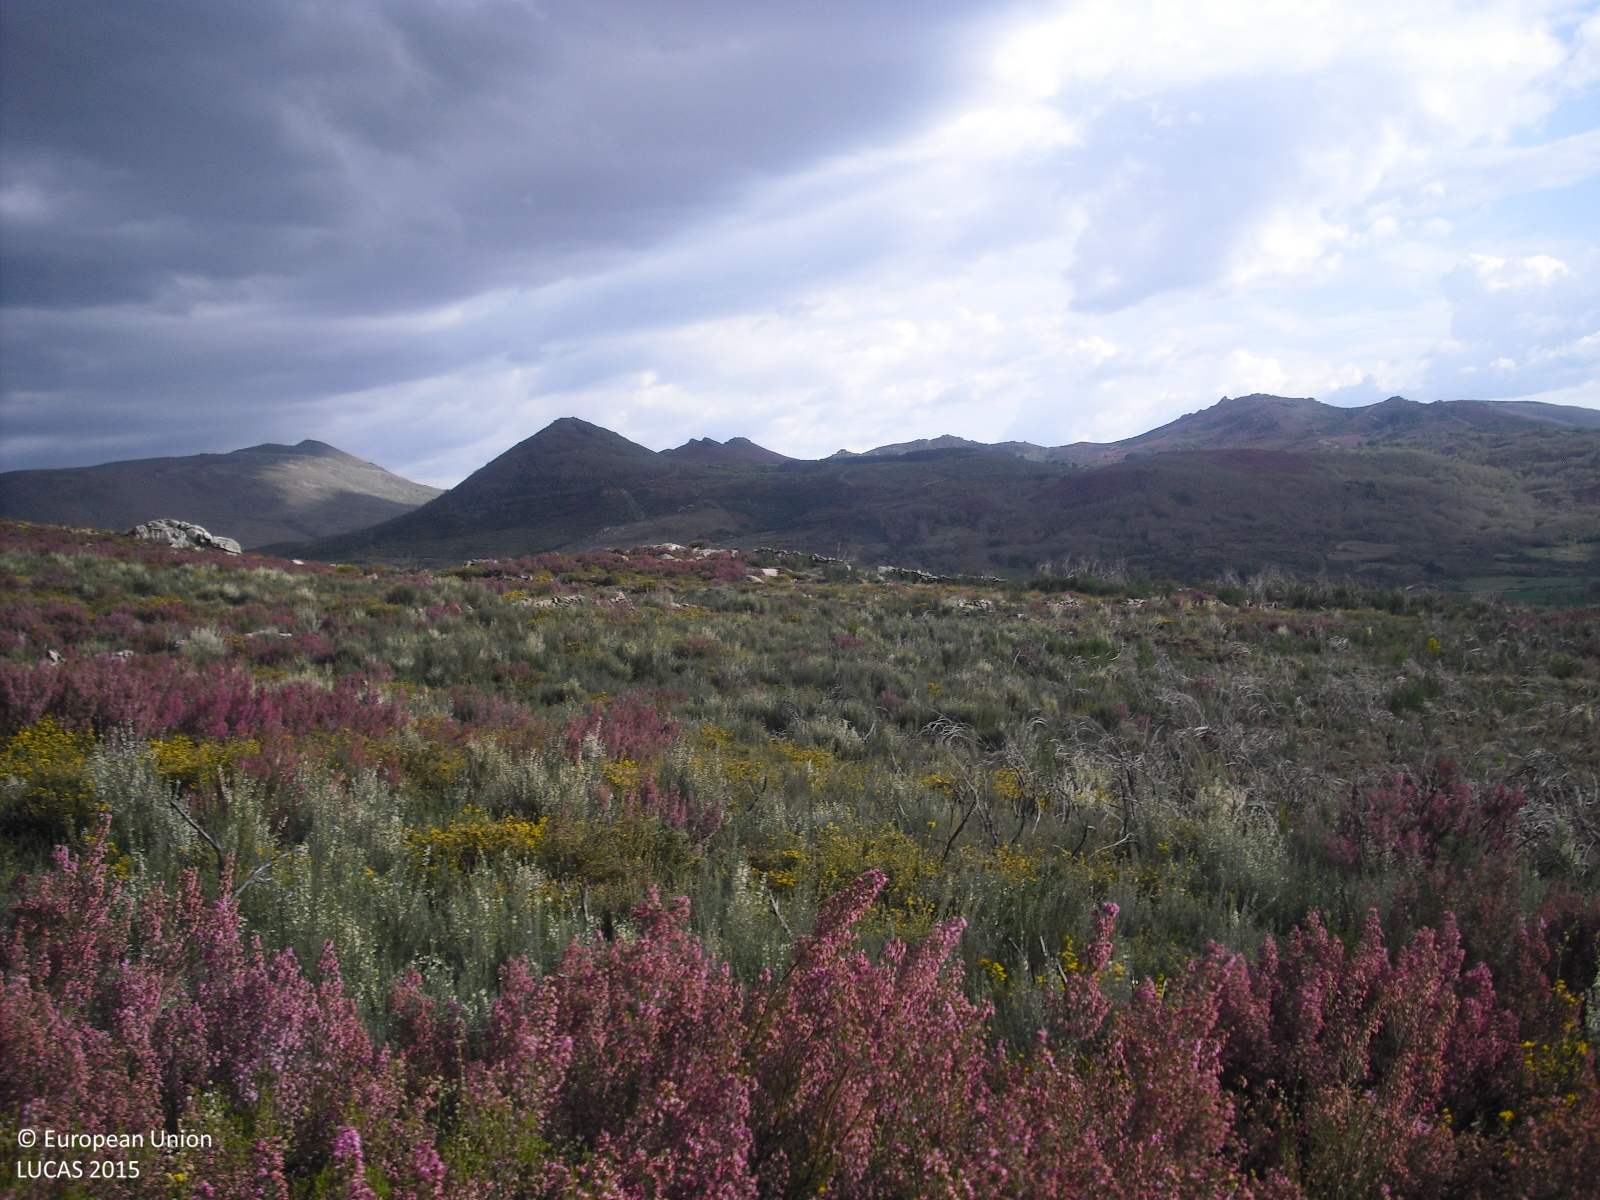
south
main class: Shrubland
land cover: Shrubland without tree cover
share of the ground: > 75 %
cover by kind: shrubs 70 %, consolidated bare surface 20 %, herbaceous plants 10 %
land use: Semi-natural and natural areas not in use
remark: Burnt area
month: April
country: ES
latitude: 41.9363
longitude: -7.7618
